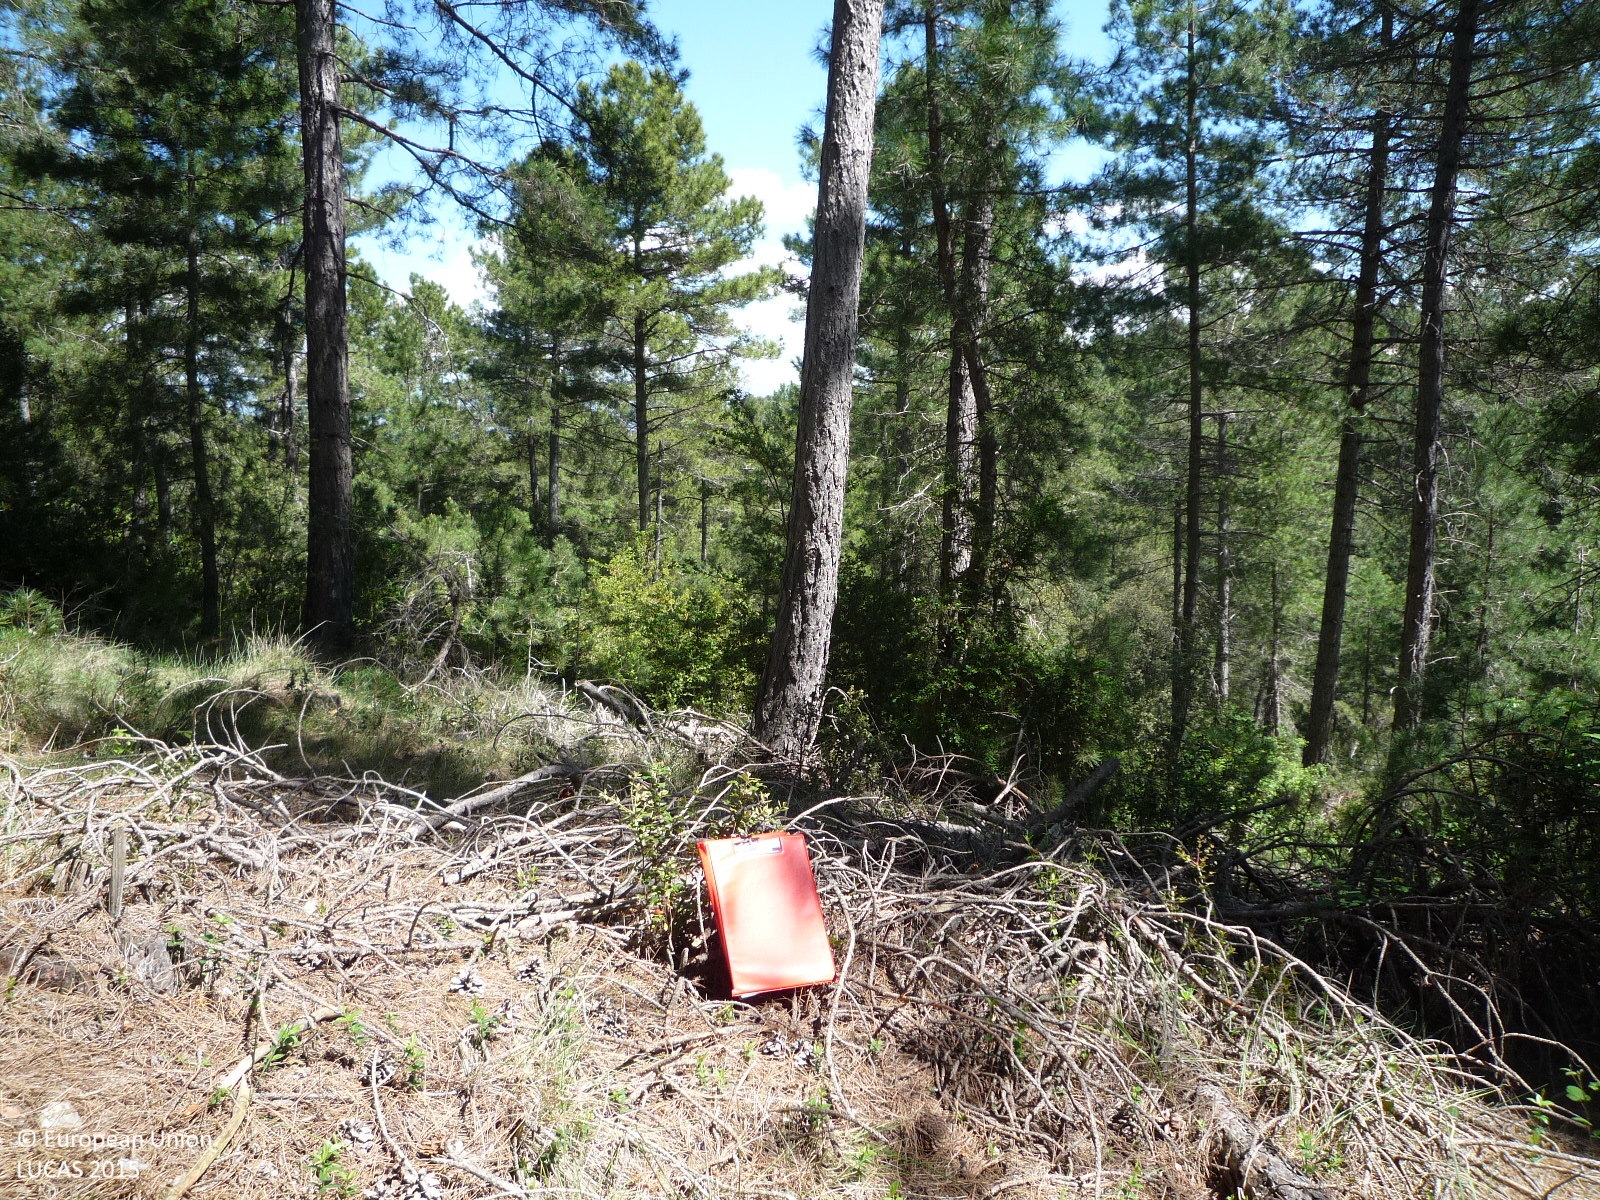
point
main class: Woodland
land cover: Pine dominated coniferous woodland
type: coniferous forest of the mediterranean region
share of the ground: > 75 %
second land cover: Spontaneously vegetated surfaces
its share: 25 - 50 %
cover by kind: coniferous forest trees 90 %, shrubs 10 %
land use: Forestry
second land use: Agriculture (excluding fallow land and kitchen gardens)
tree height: > 5 m
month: May
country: ES
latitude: 41.8005
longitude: 1.6497
